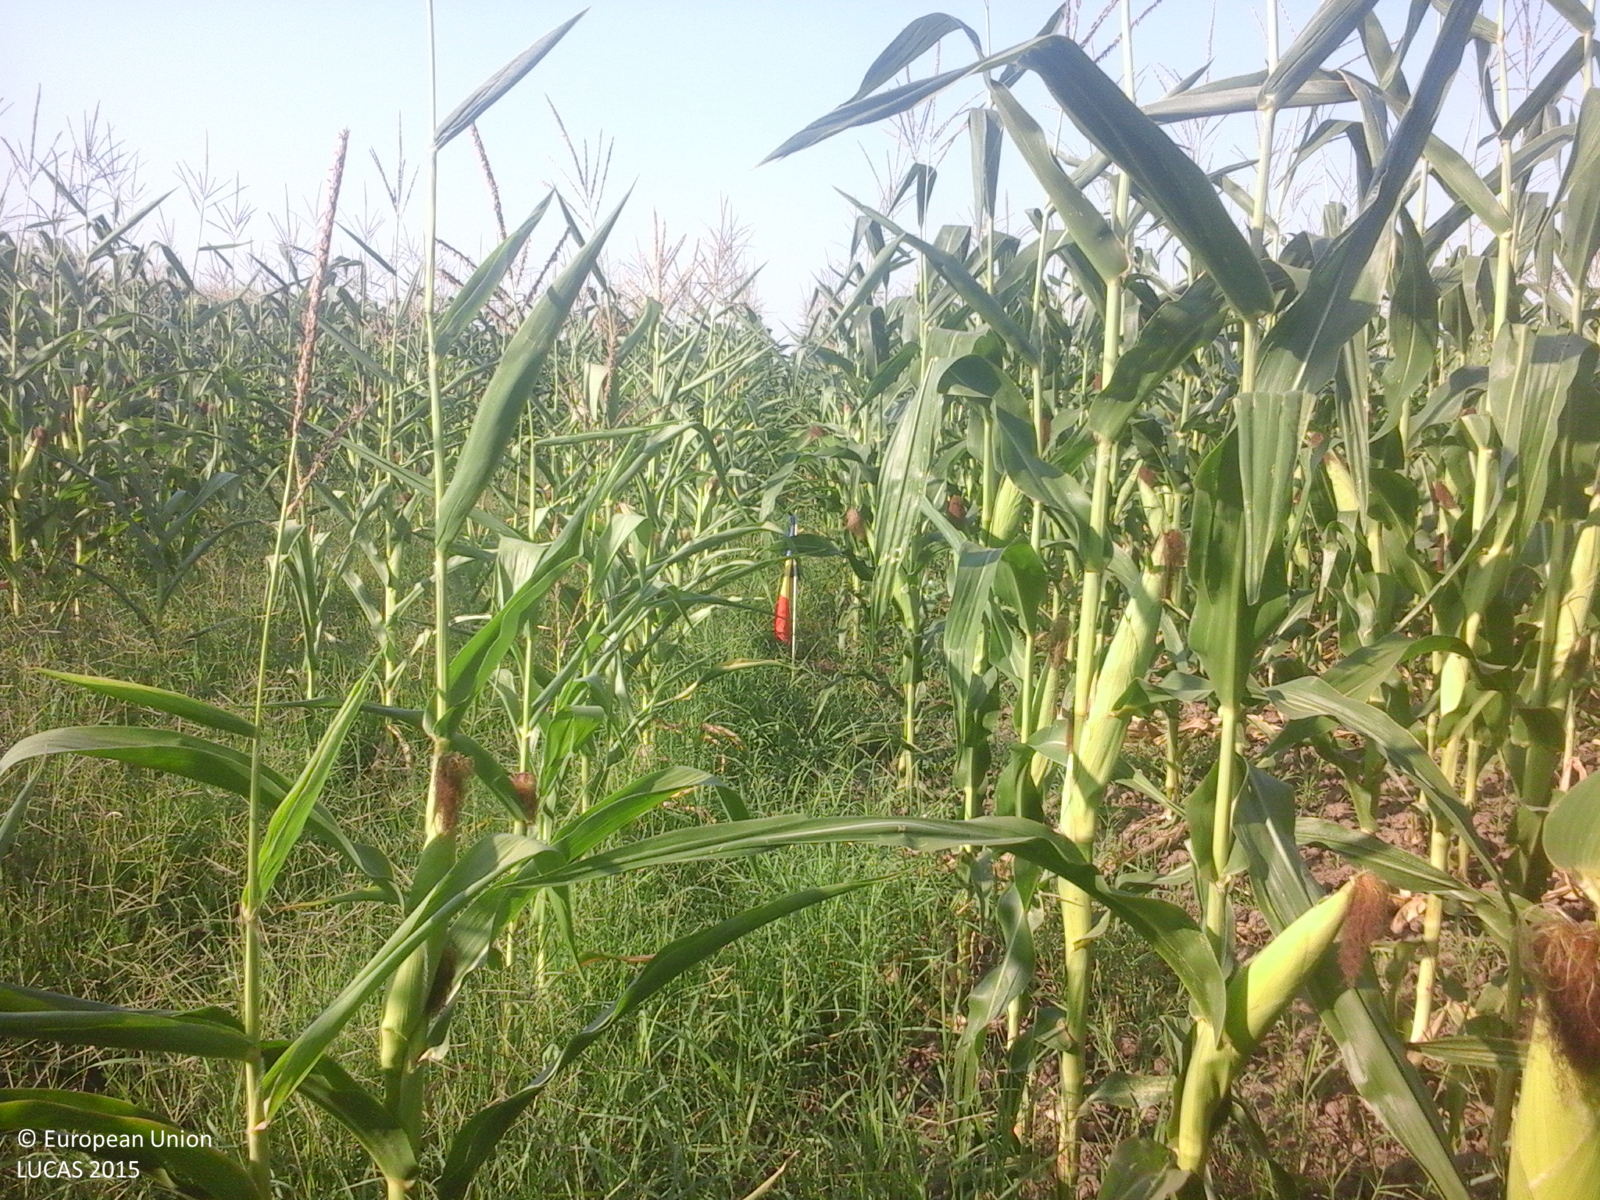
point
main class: Cropland
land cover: Maize
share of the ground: > 75 %
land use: Agriculture (excluding fallow land and kitchen gardens)
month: July
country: RO
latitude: 44.9610
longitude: 27.3205
